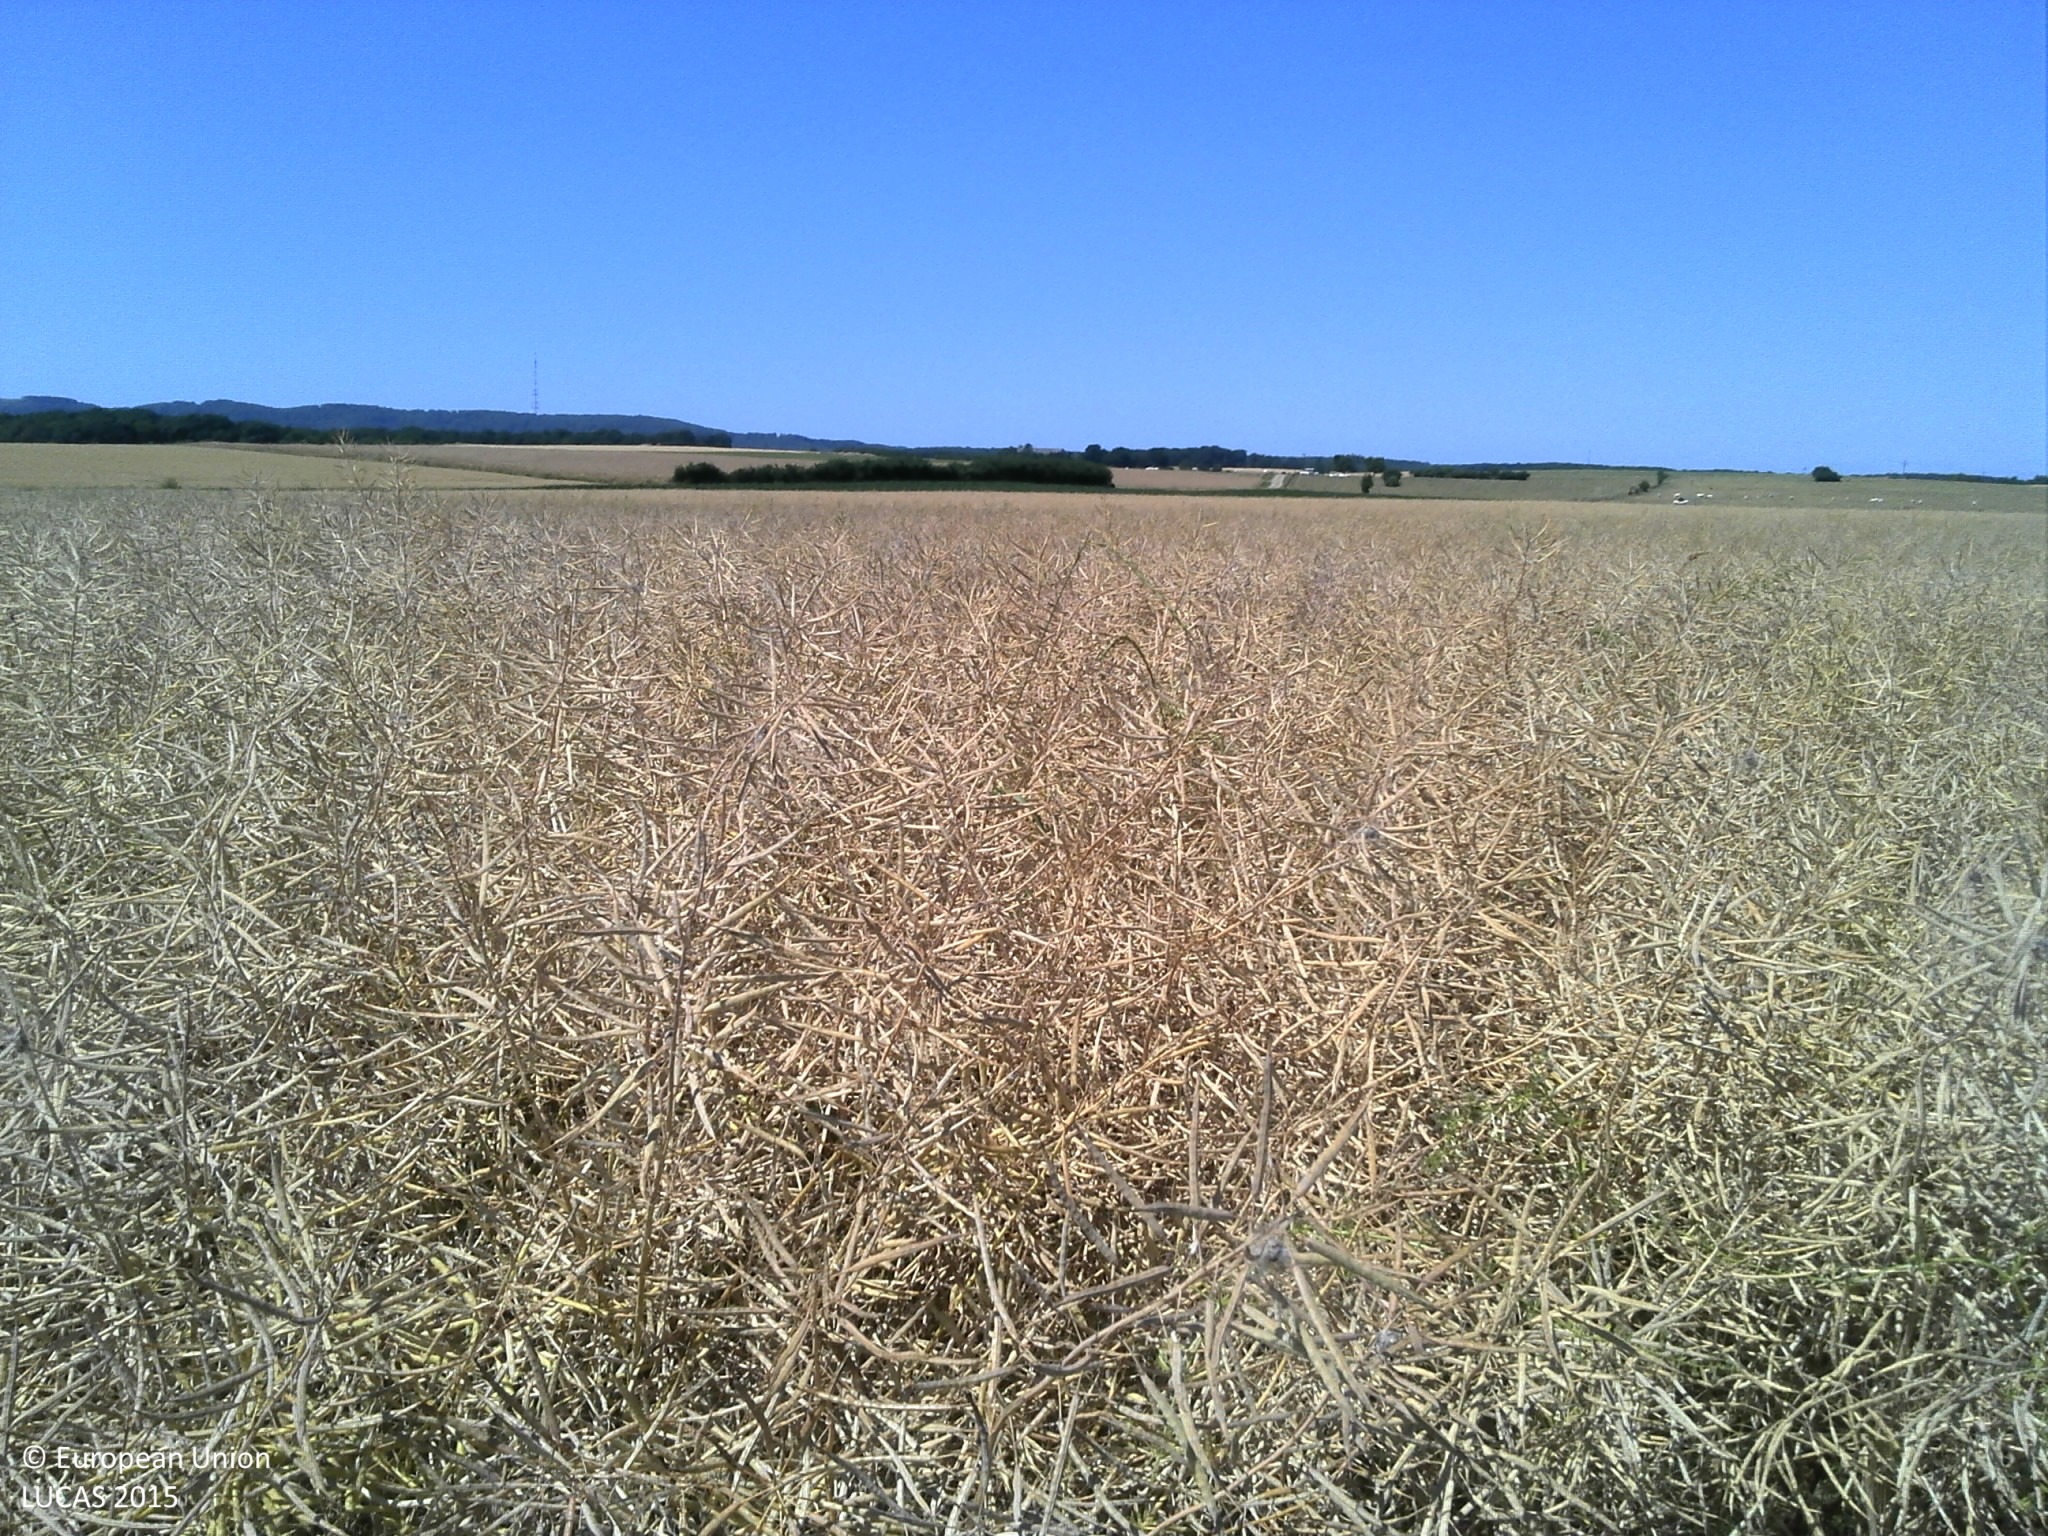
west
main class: Cropland
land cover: Rape and turnip rape
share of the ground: > 75 %
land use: Agriculture (excluding fallow land and kitchen gardens)
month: July
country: FR
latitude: 49.4730
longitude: 6.2045
